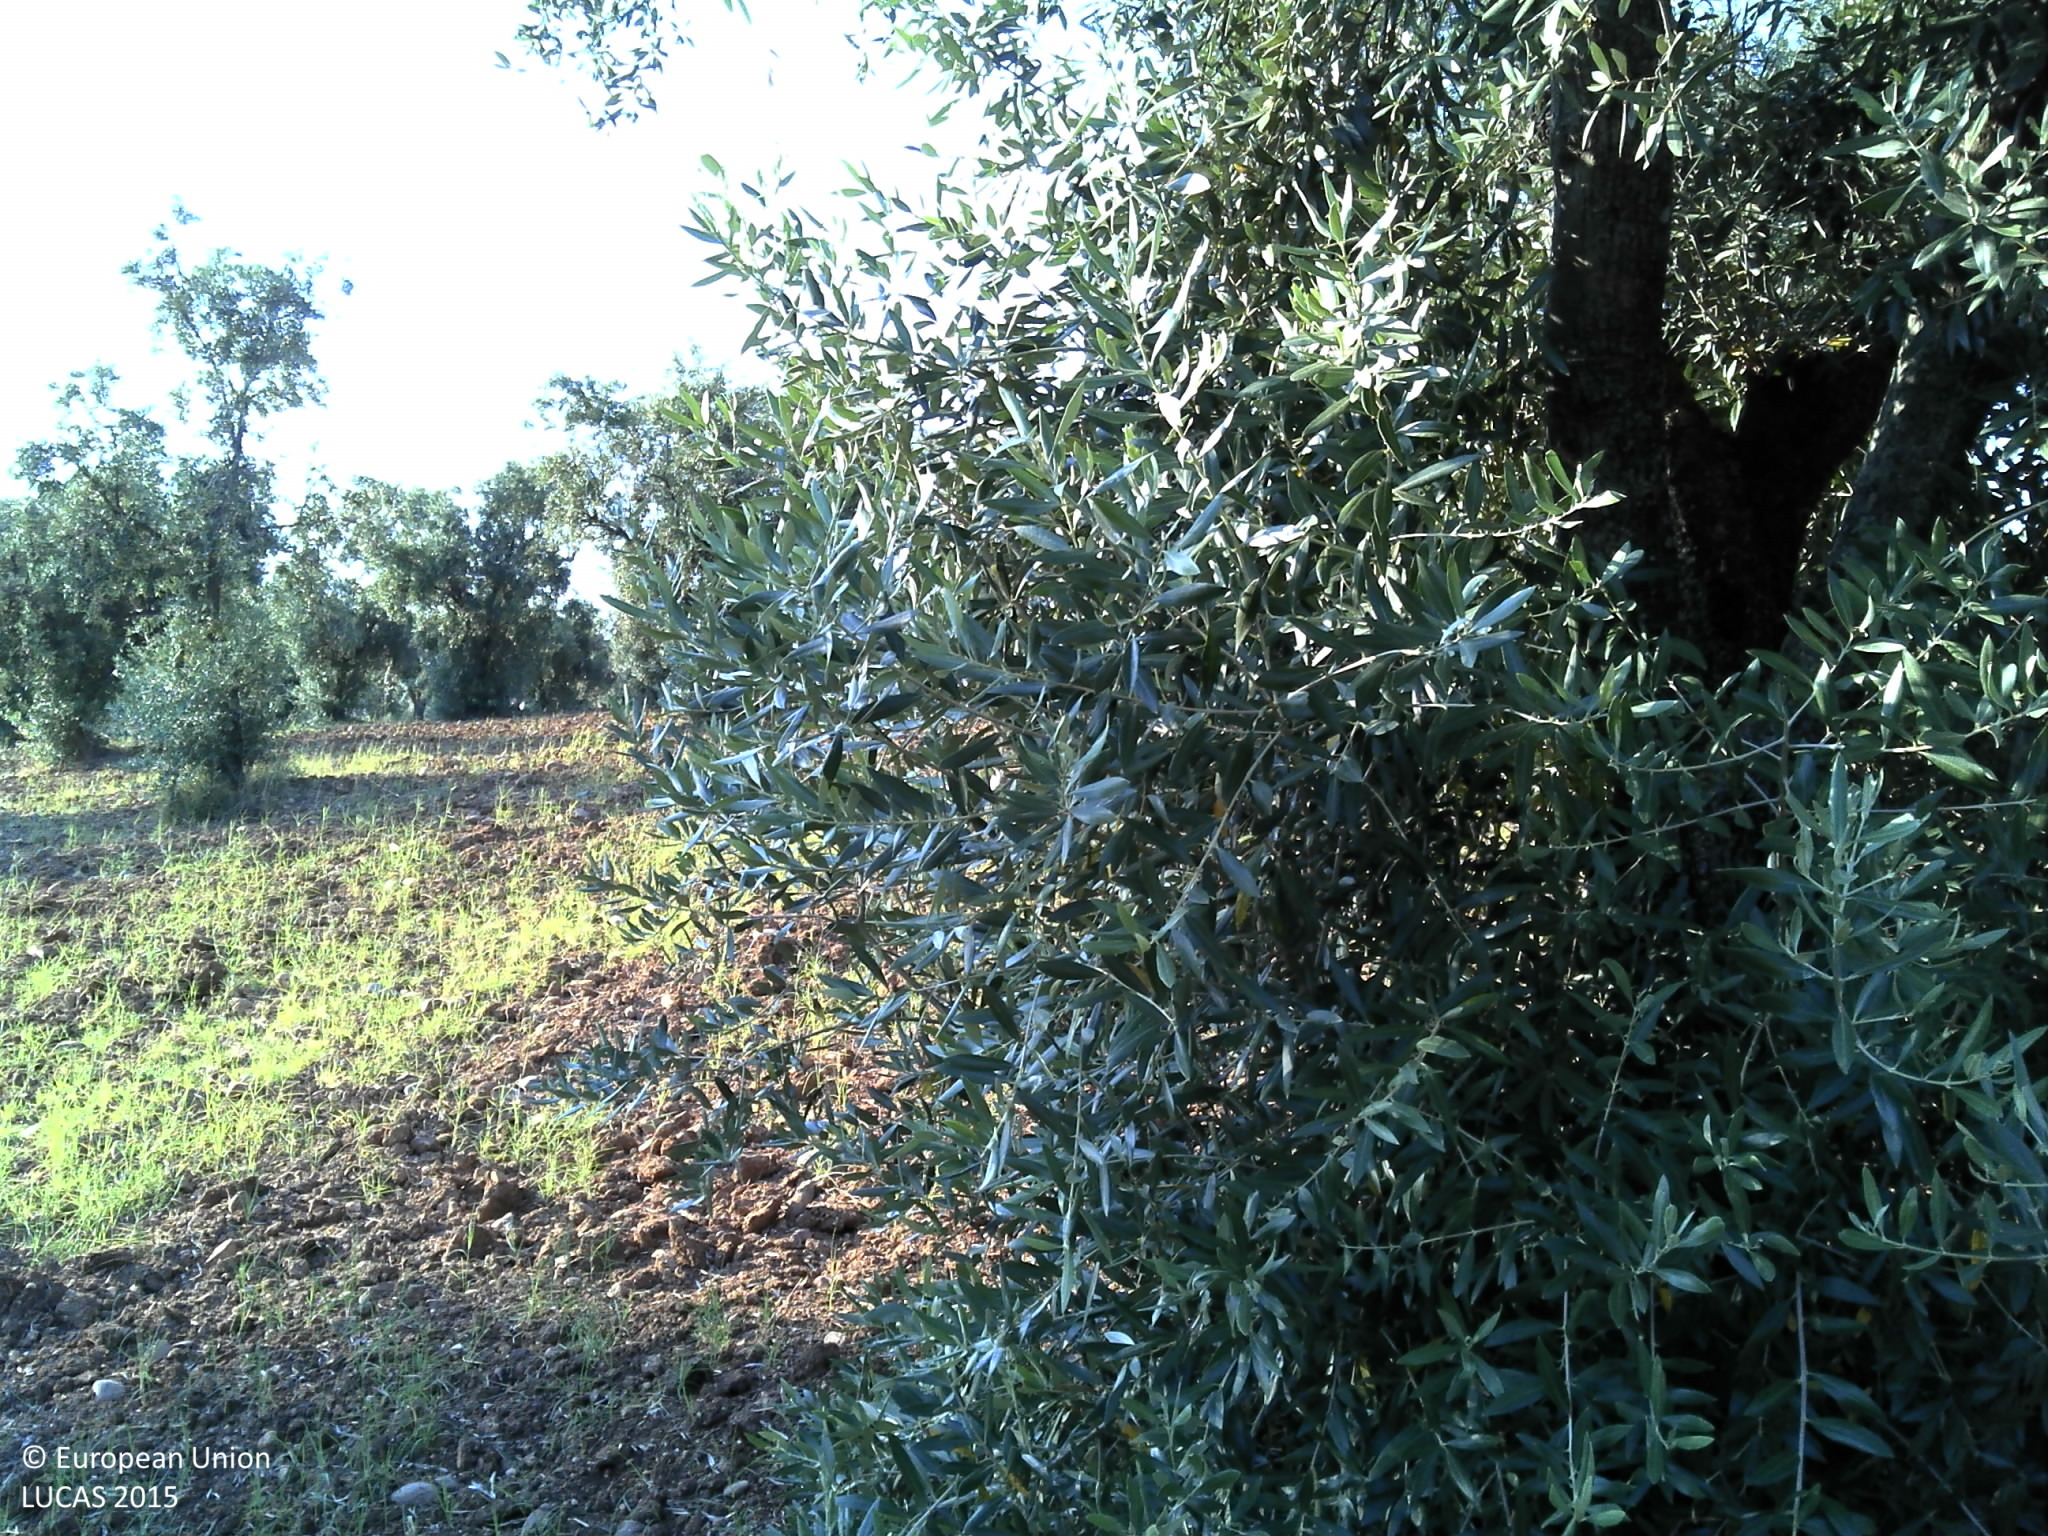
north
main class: Cropland
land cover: Olive groves
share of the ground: 25 - 50 %
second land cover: Grassland without tree/shrub cover
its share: 10 - 25 %
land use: Agriculture (excluding fallow land and kitchen gardens)
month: June
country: PT
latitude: 38.1258
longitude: -7.6028
